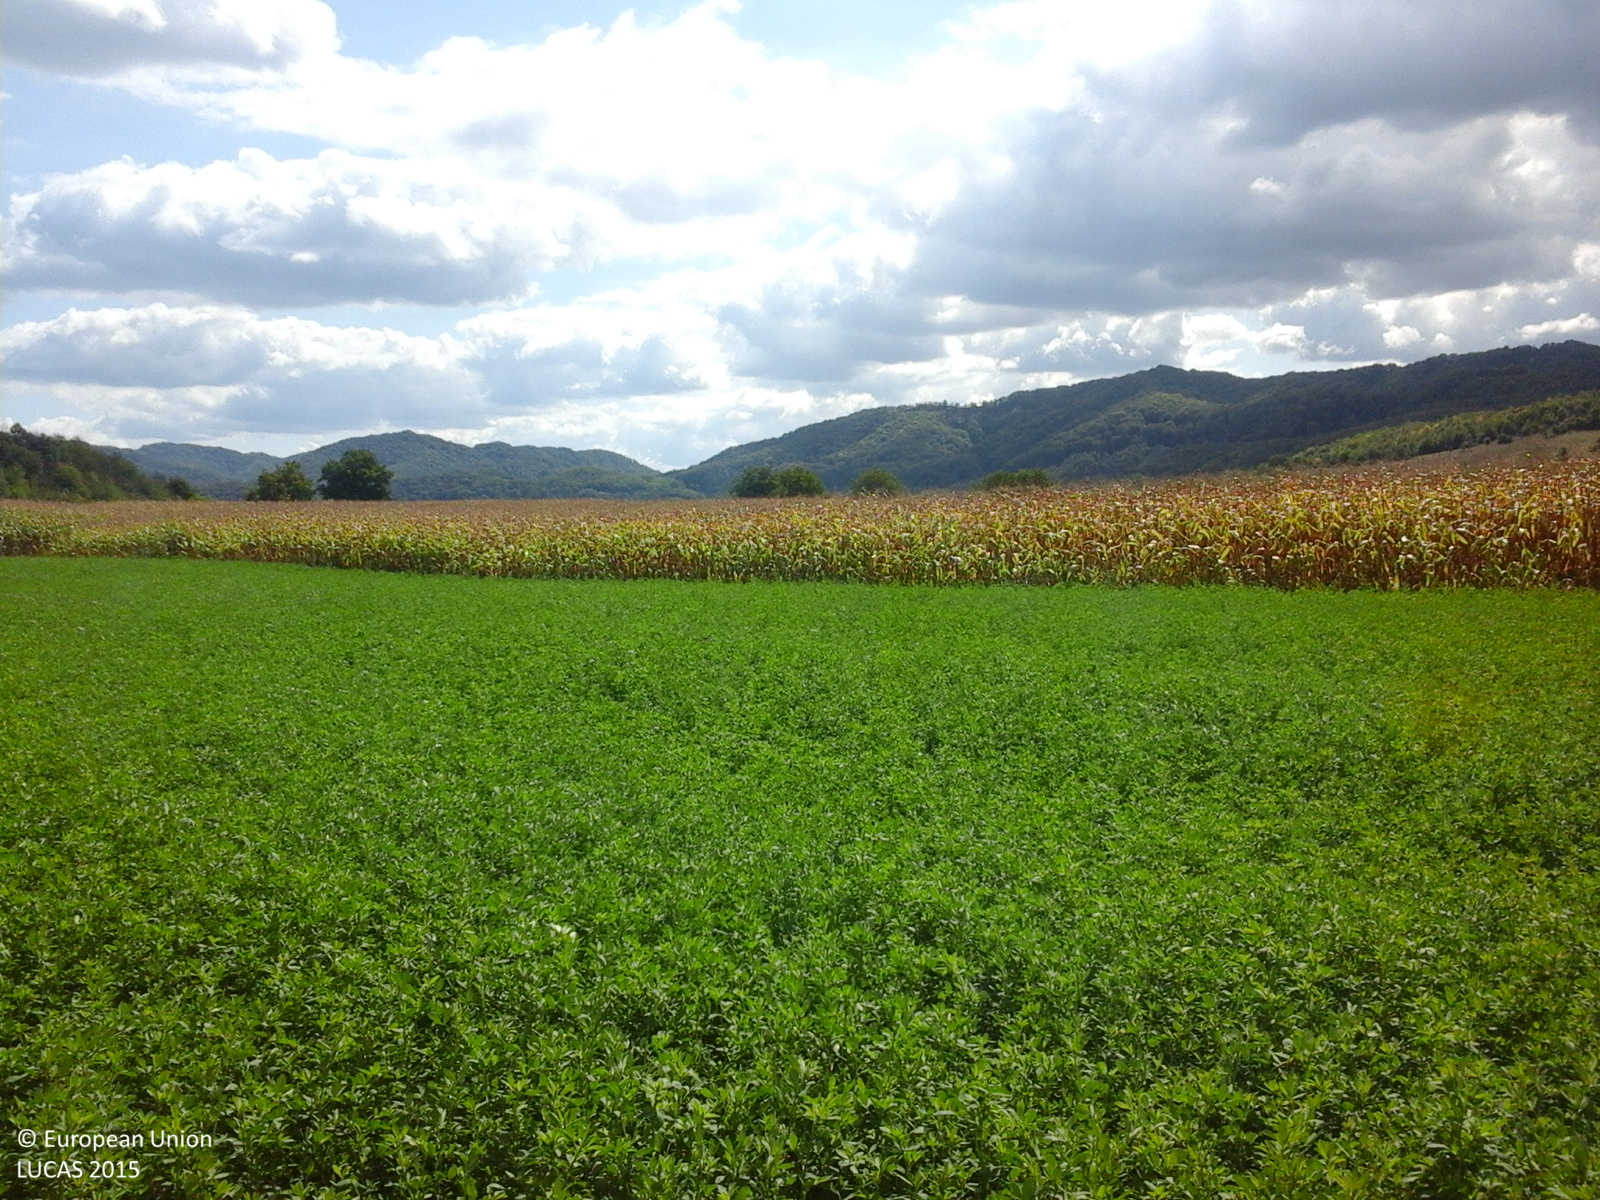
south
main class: Cropland
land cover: Maize
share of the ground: > 75 %
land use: Agriculture (excluding fallow land and kitchen gardens)
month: September
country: RO
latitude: 47.3220
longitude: 23.4480
